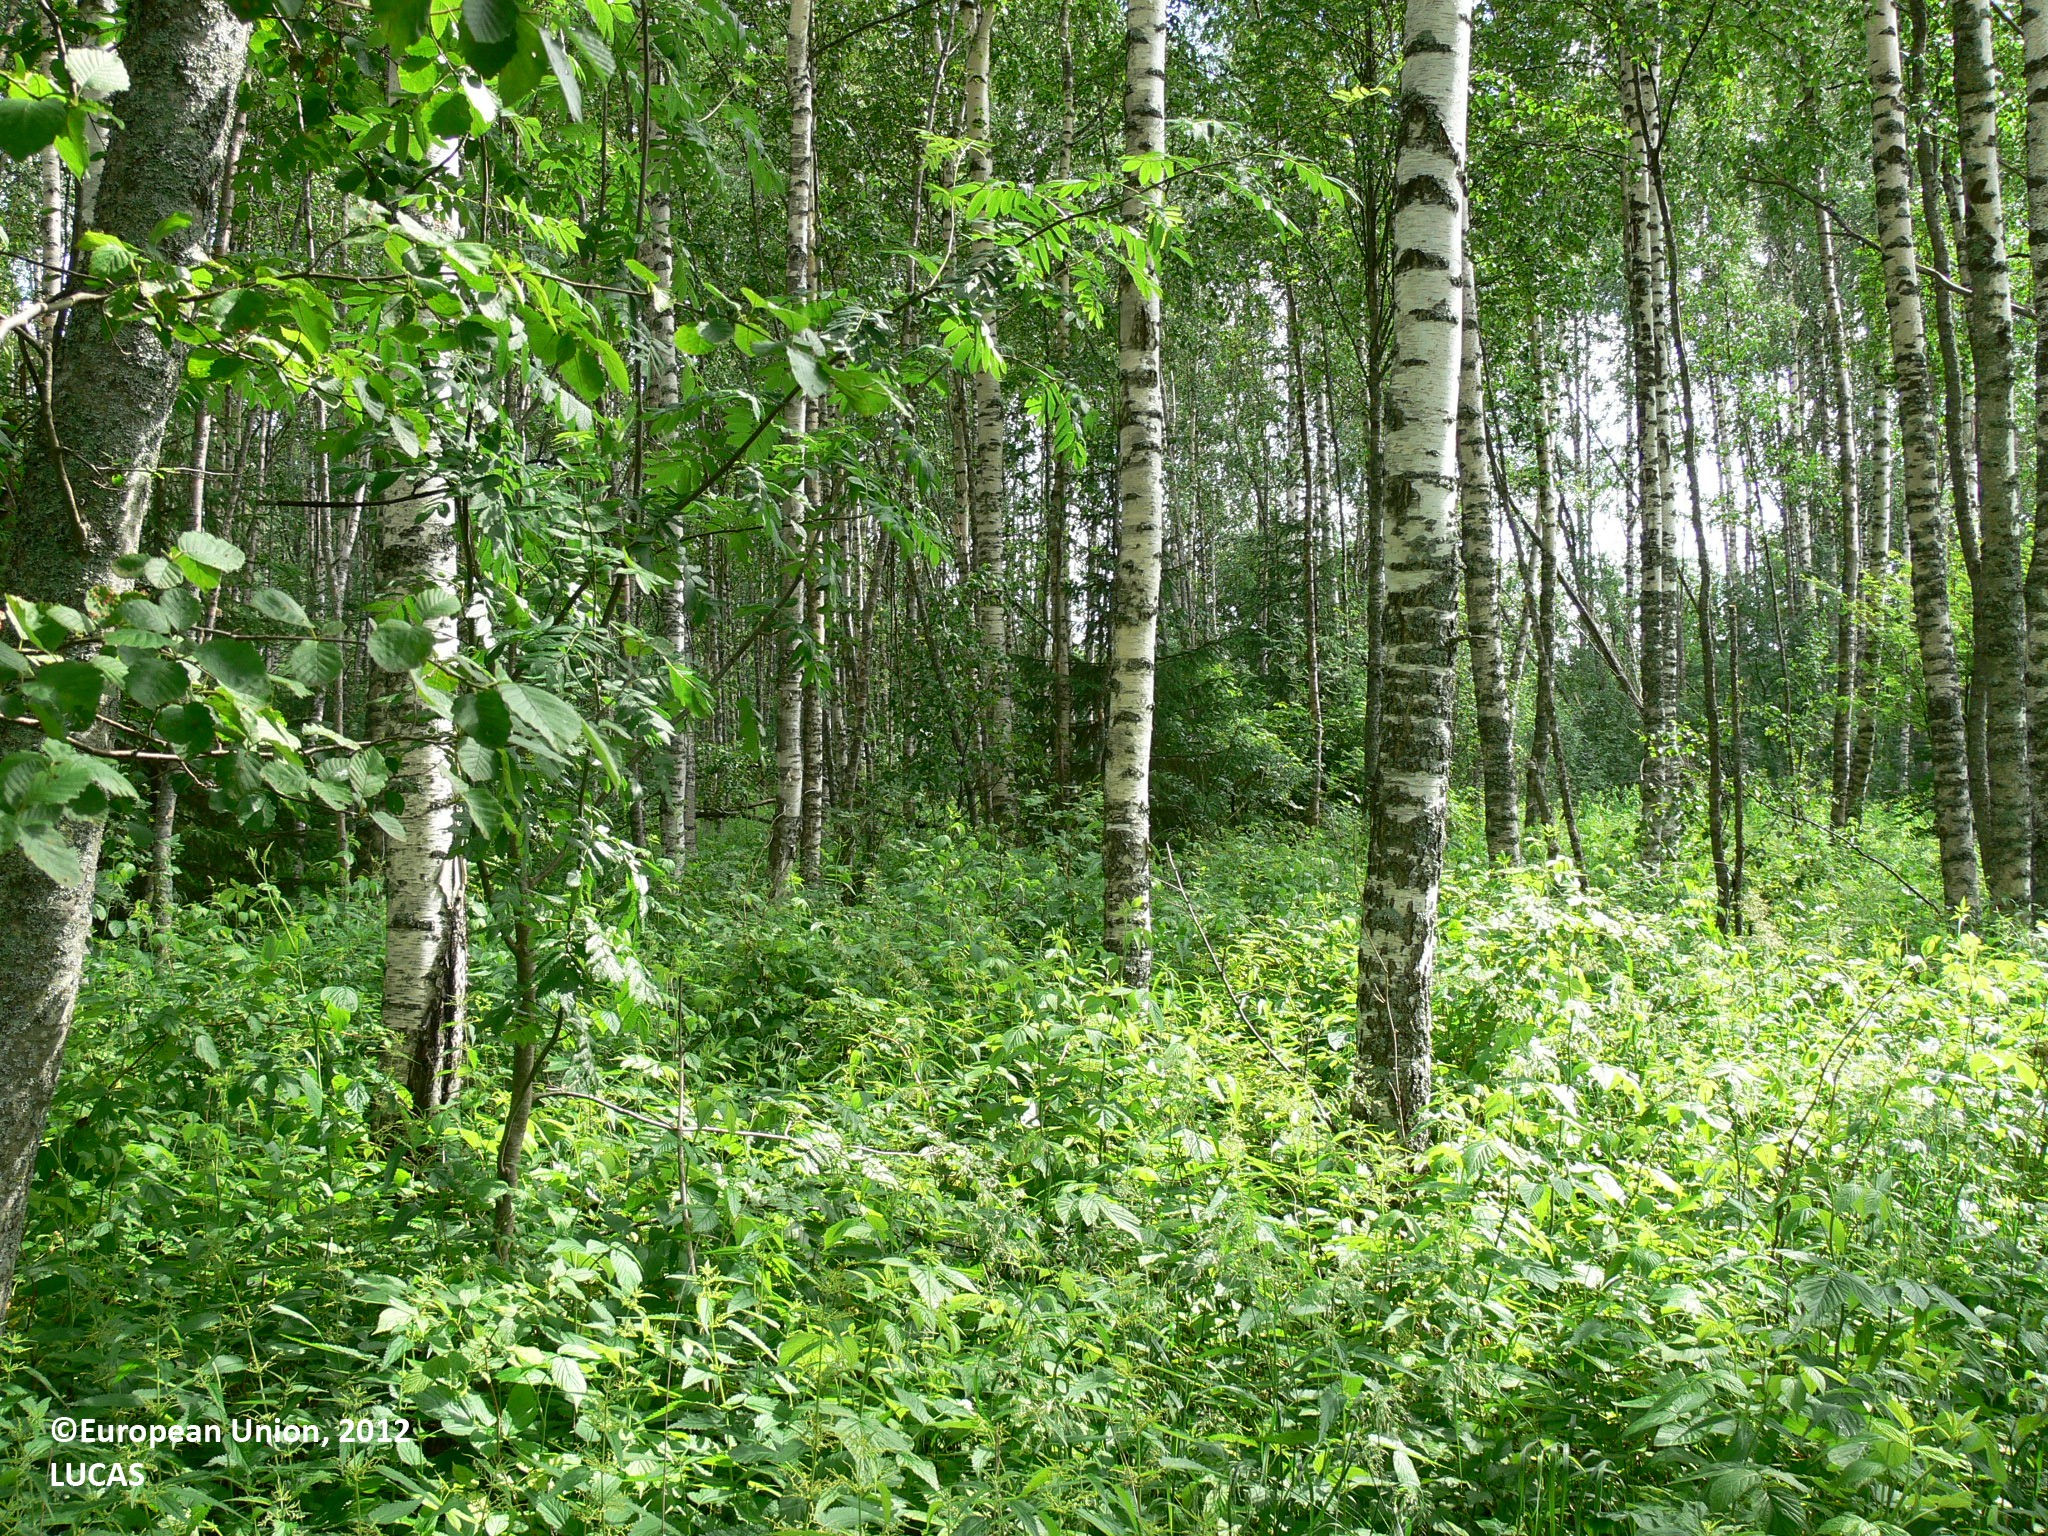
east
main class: Woodland
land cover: Broadleaved woodland
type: boreal forest
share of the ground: > 75 %
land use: Forestry
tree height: > 5 m
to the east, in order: Broadleaved woodland; Ditches and canals; Broadleaved woodland; Ditches and canals; Broadleaved woodland; Ditches and canals; Broadleaved woodland; Ditches and canals; Broadleaved woodland; Ditches and canals; Spruce dominated mixed woodland; Spruce dominated coniferous woodland
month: July
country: FI
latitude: 63.1694
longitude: 30.0536
